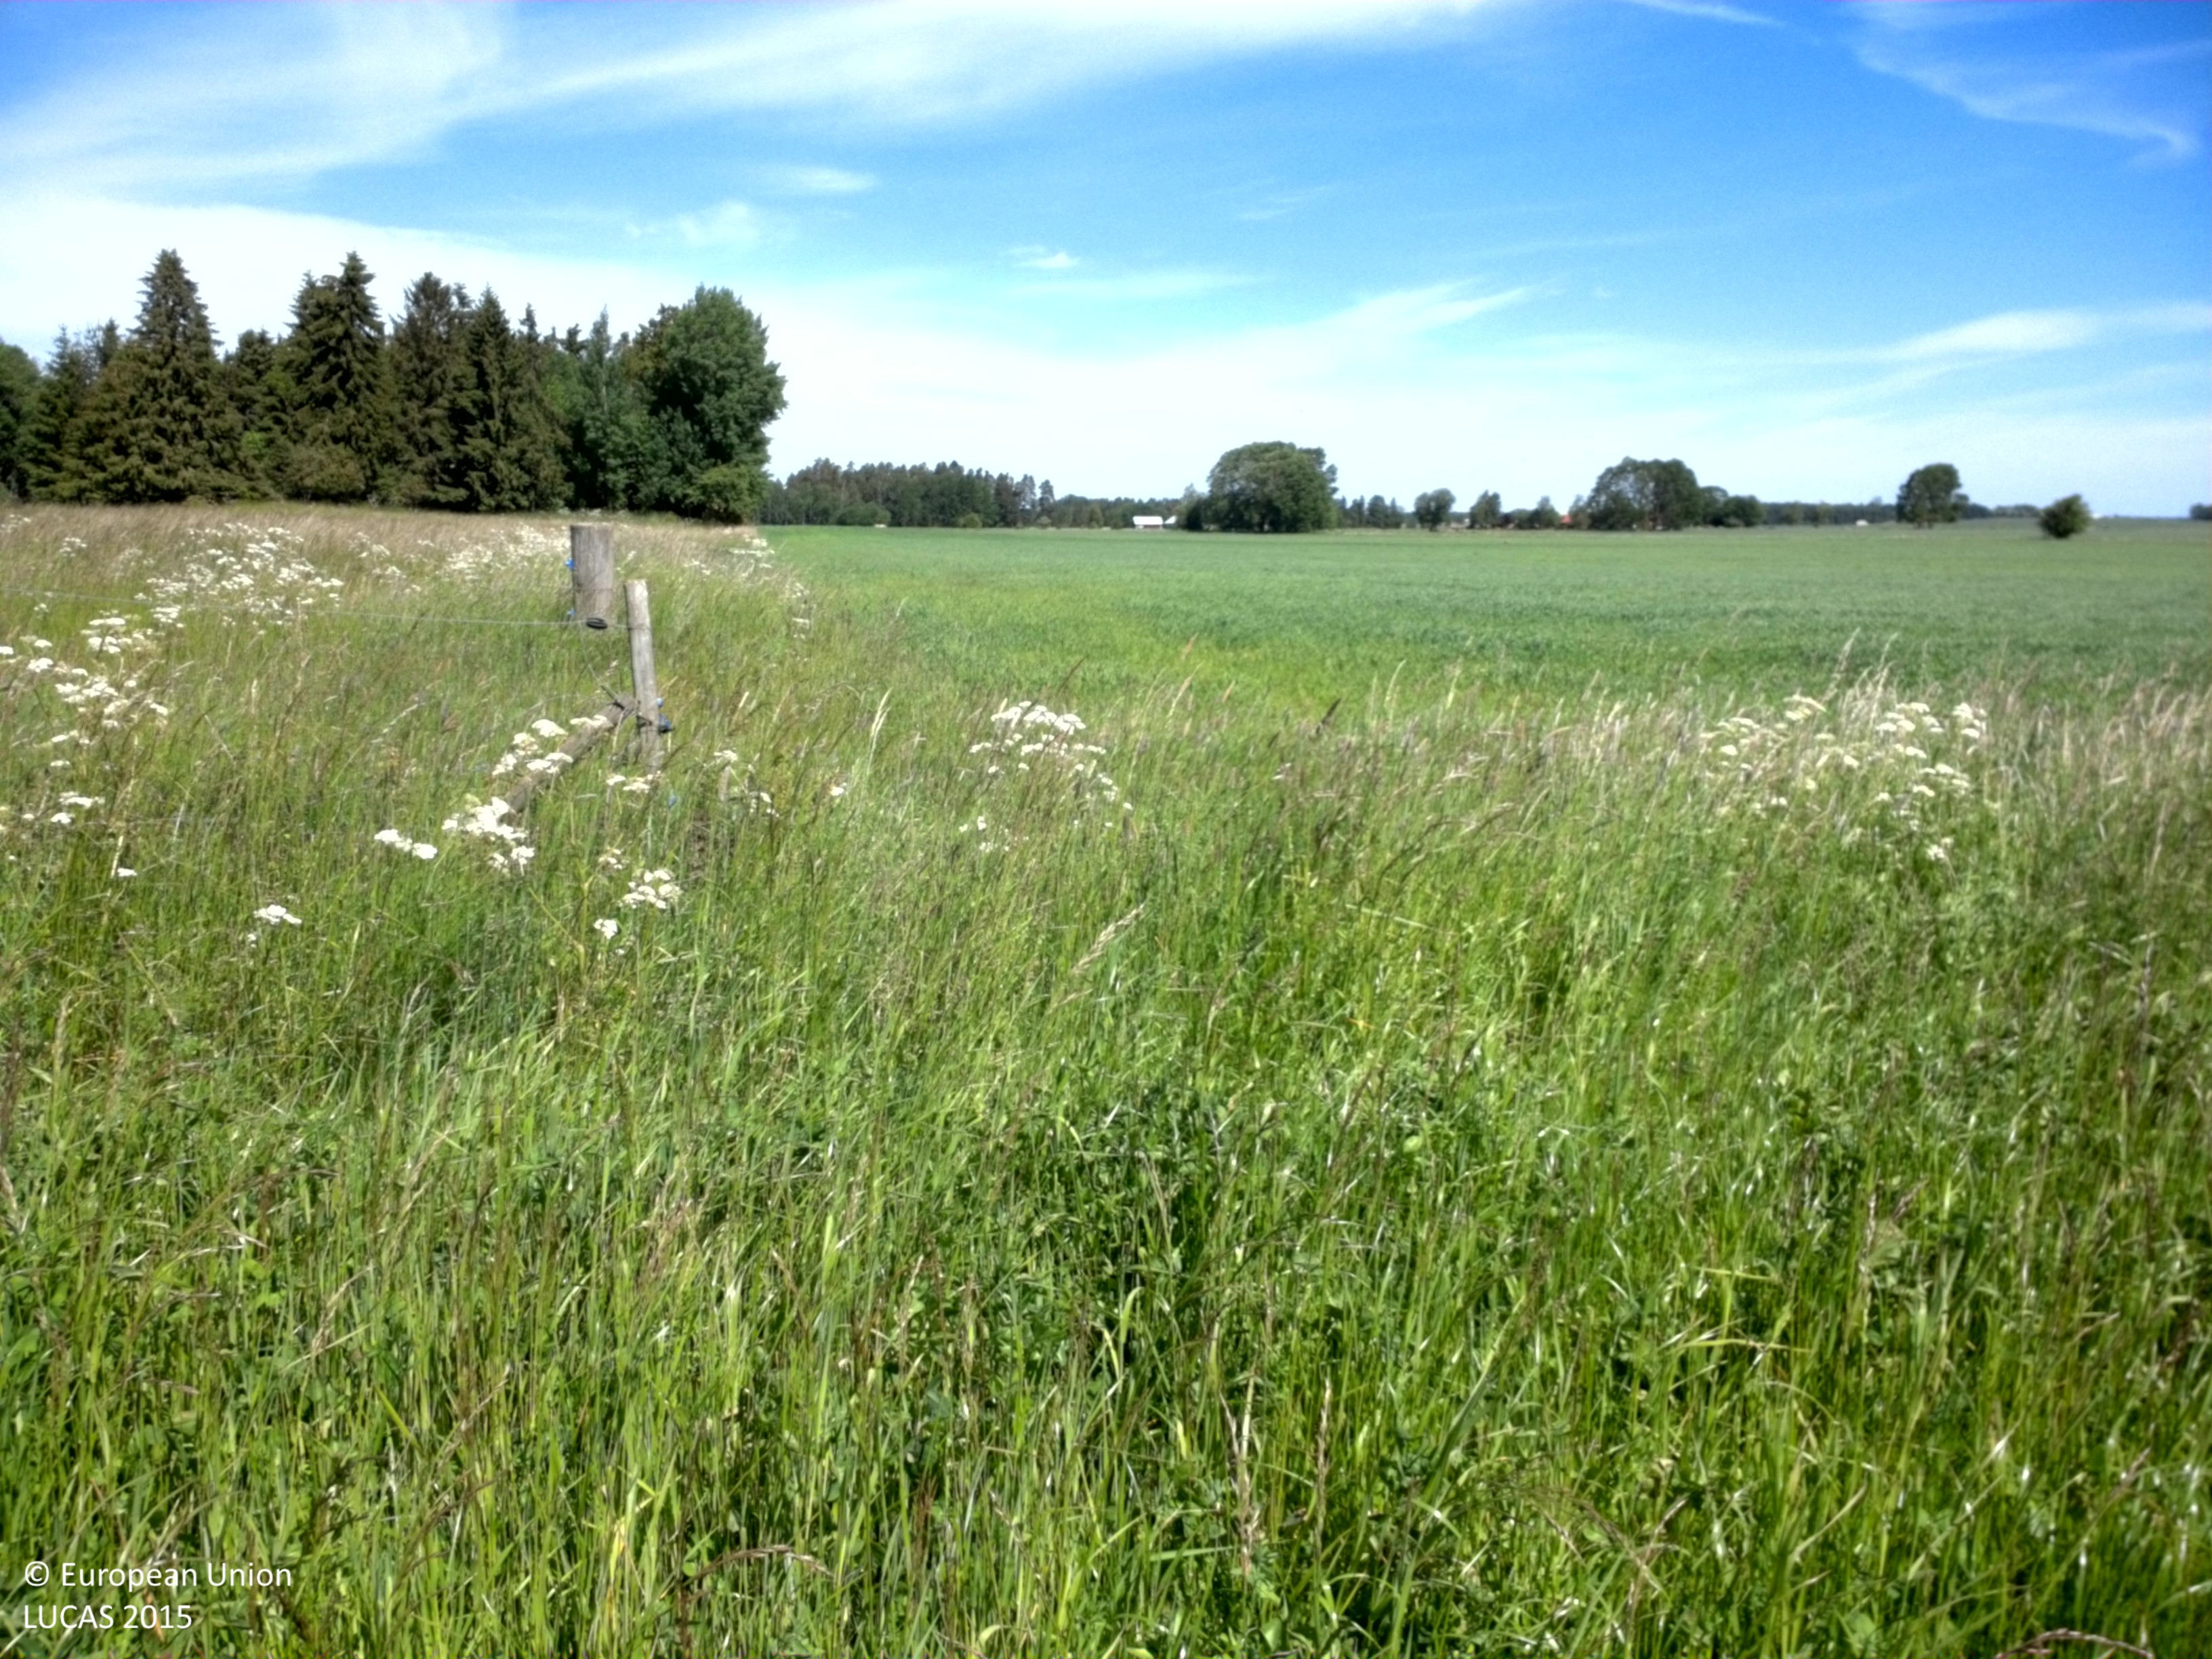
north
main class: Cropland
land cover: Other leguminous and mixtures for fodder
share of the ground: > 75 %
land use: Agriculture (excluding fallow land and kitchen gardens)
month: June
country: SE
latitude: 58.4898
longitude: 15.3977
